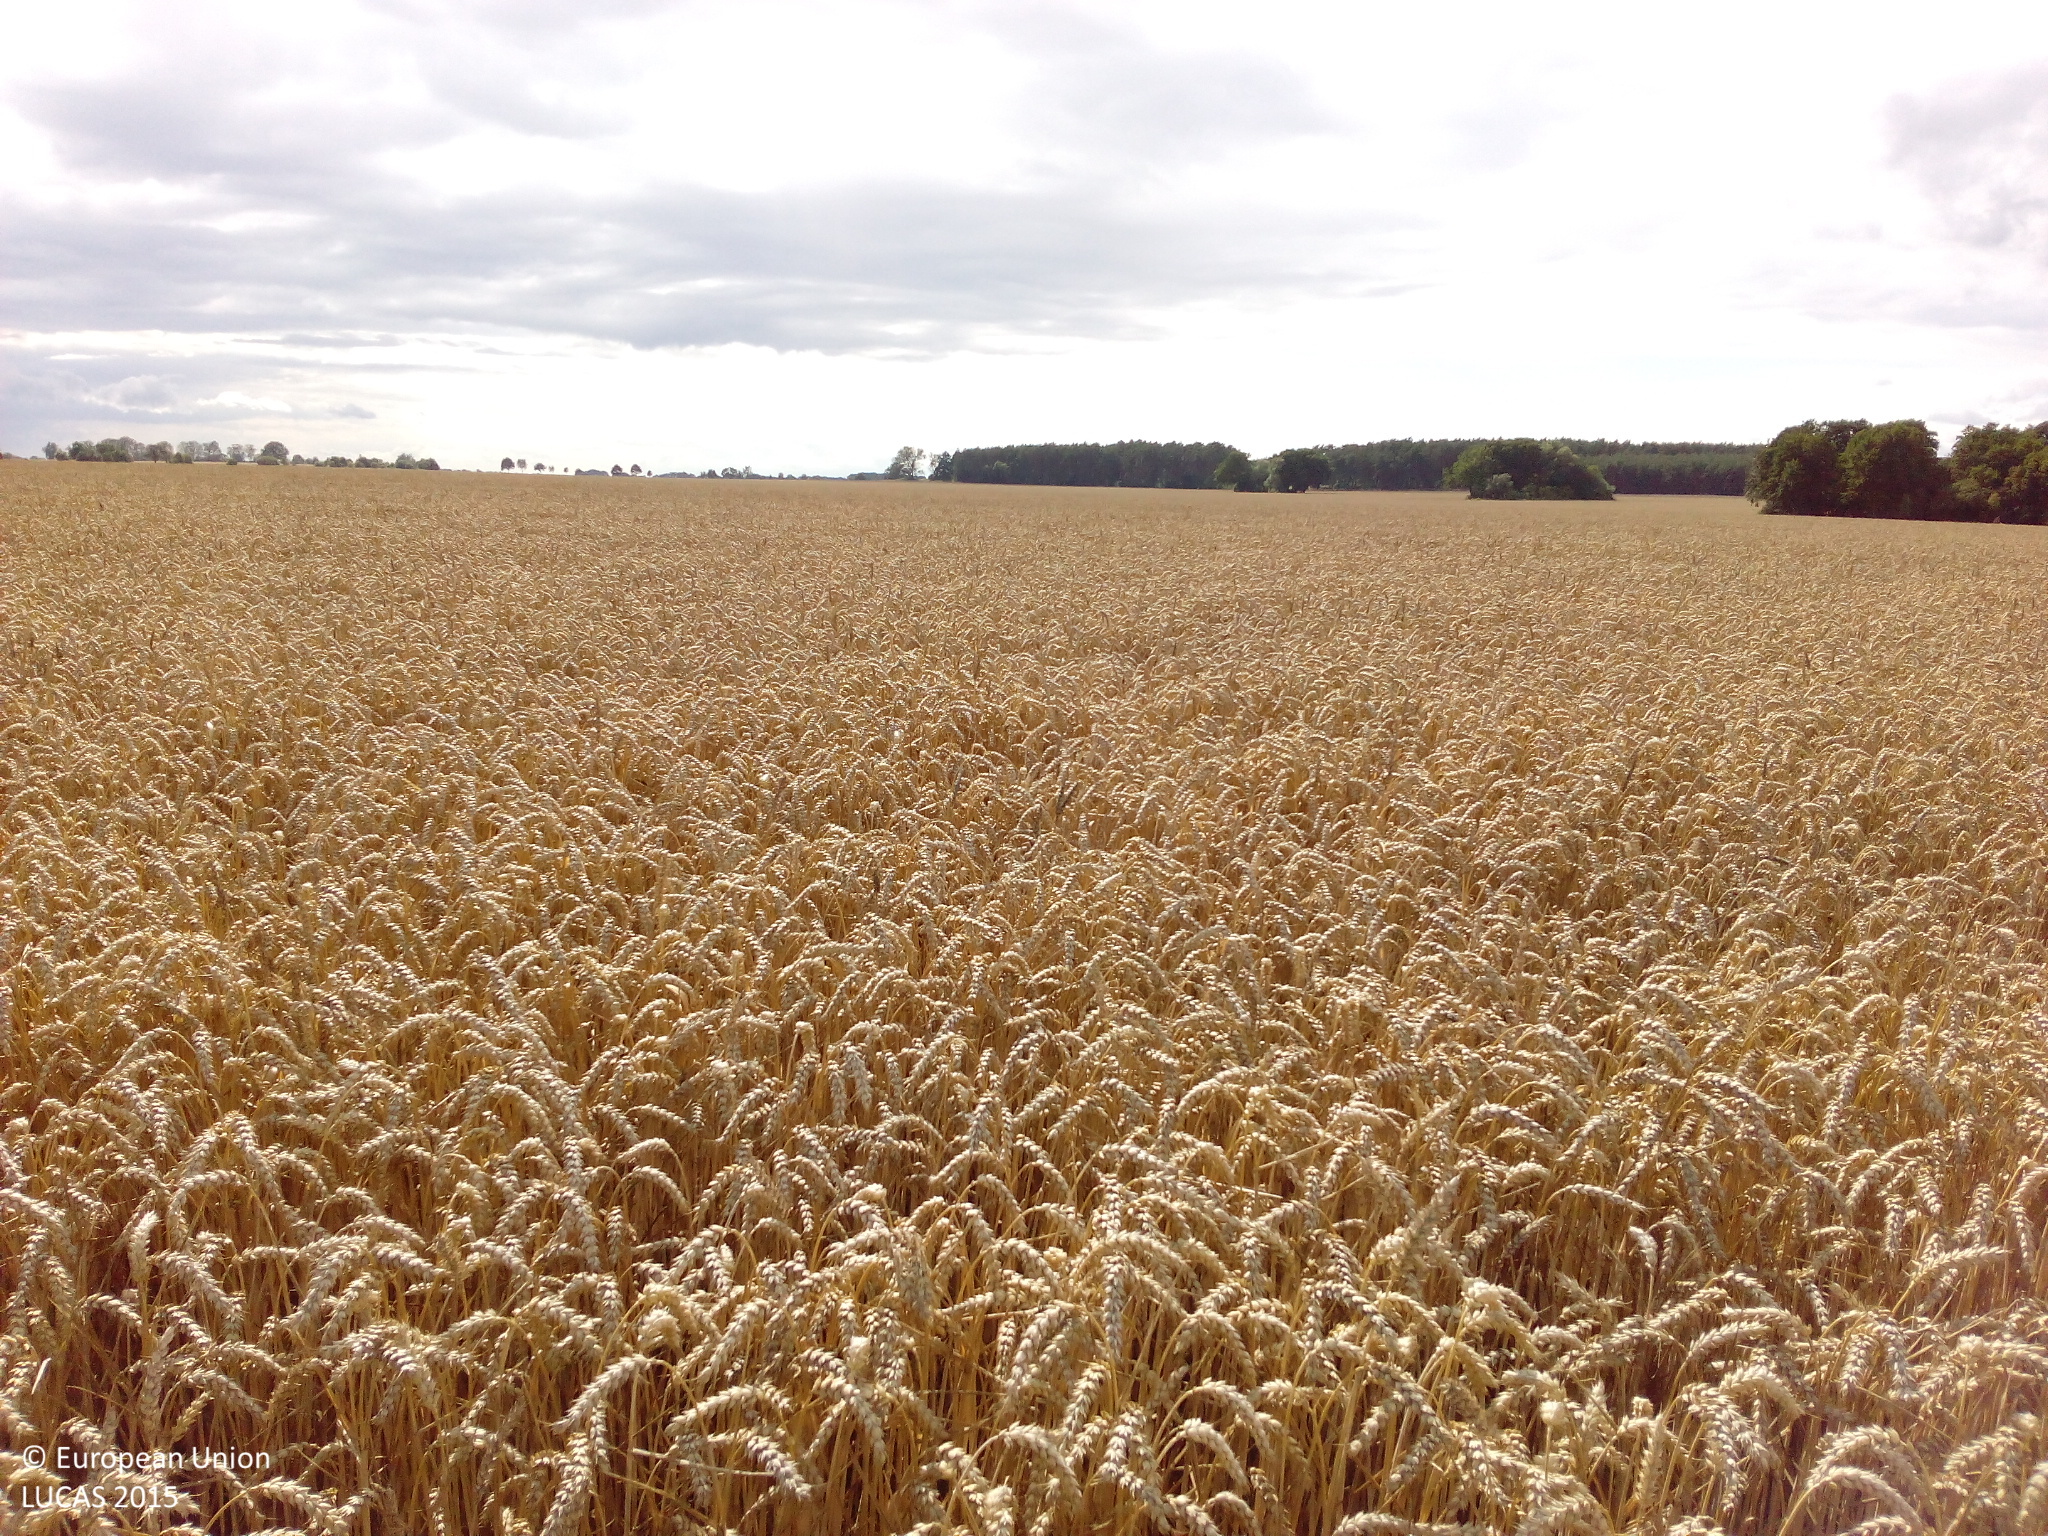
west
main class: Cropland
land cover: Common wheat
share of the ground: > 75 %
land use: Agriculture (excluding fallow land and kitchen gardens)
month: July
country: DE
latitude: 53.1752
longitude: 11.6302
